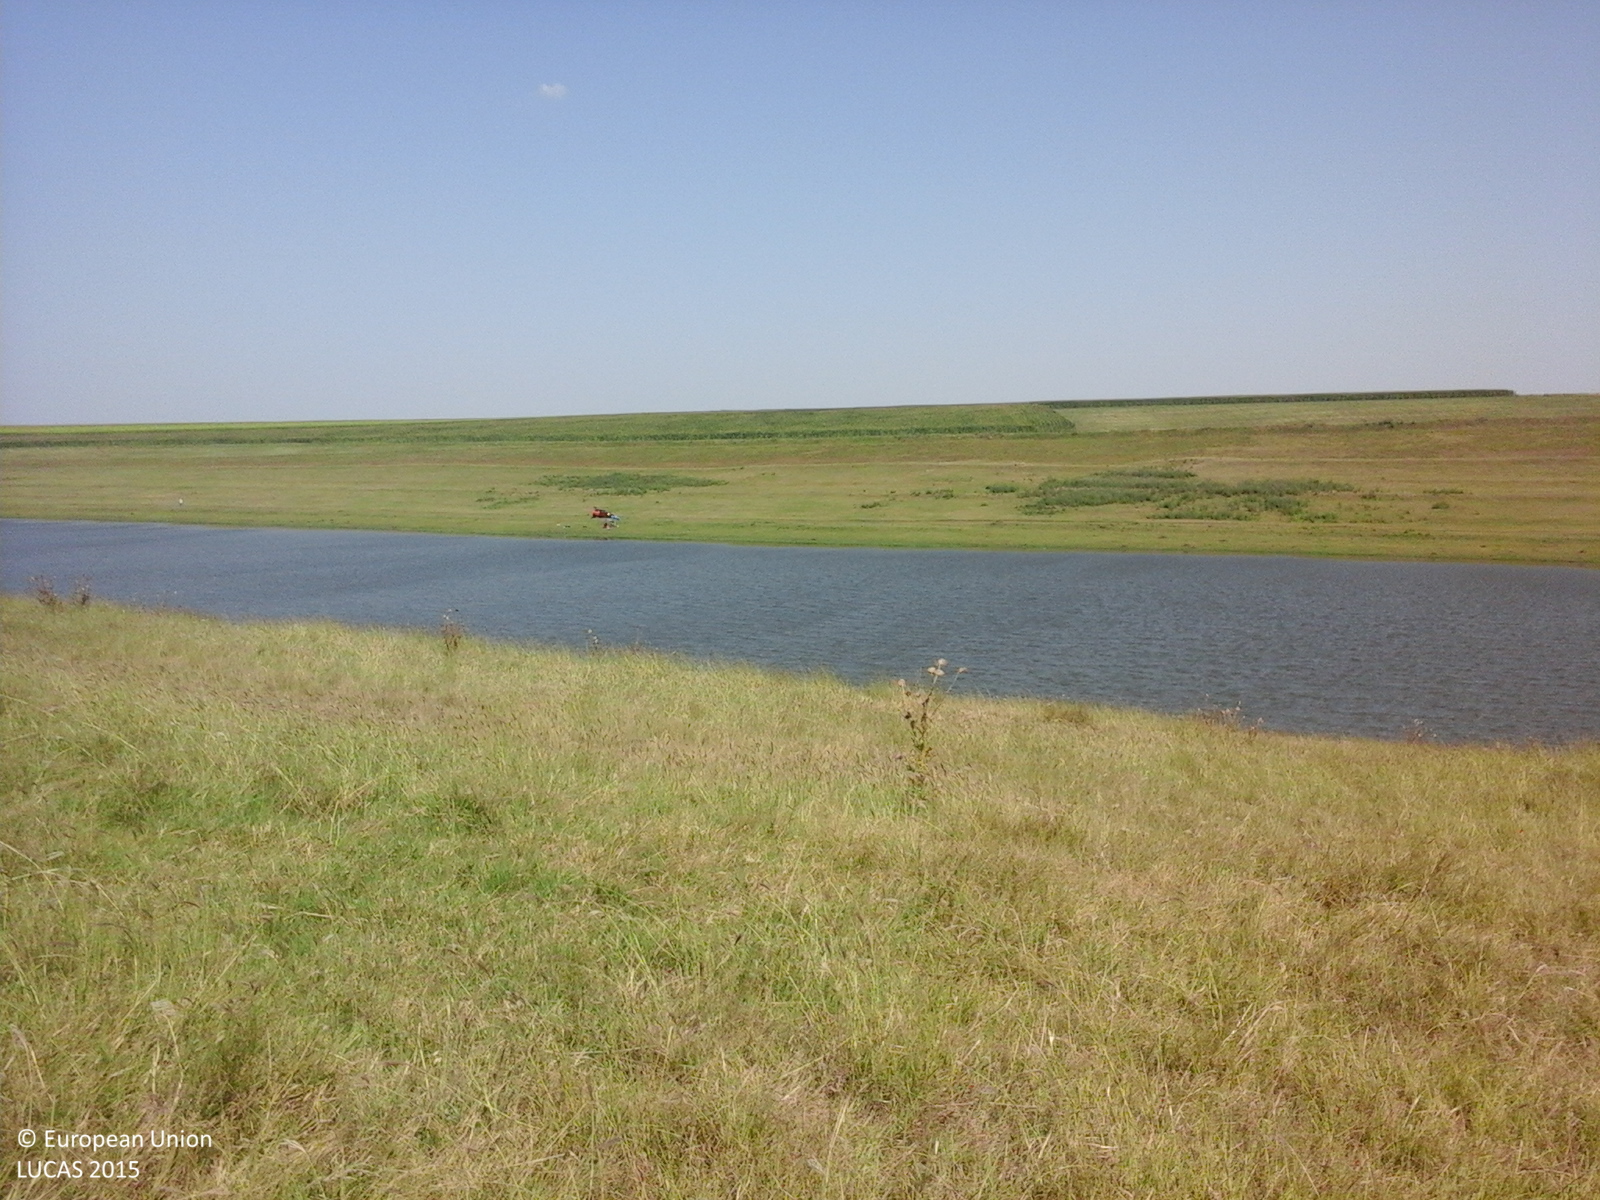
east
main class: Grassland
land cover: Grassland without tree/shrub cover
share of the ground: > 75 %
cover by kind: herbaceous plants 100 %
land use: Agriculture (excluding fallow land and kitchen gardens)
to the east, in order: Grassland without tree/shrub cover; Tracks; Grassland without tree/shrub cover; Tracks; Grassland without tree/shrub cover; Inland salty water bodies; Grassland without tree/shrub cover; Tracks; Grassland without tree/shrub cover
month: July
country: RO
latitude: 44.3466
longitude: 26.9217
